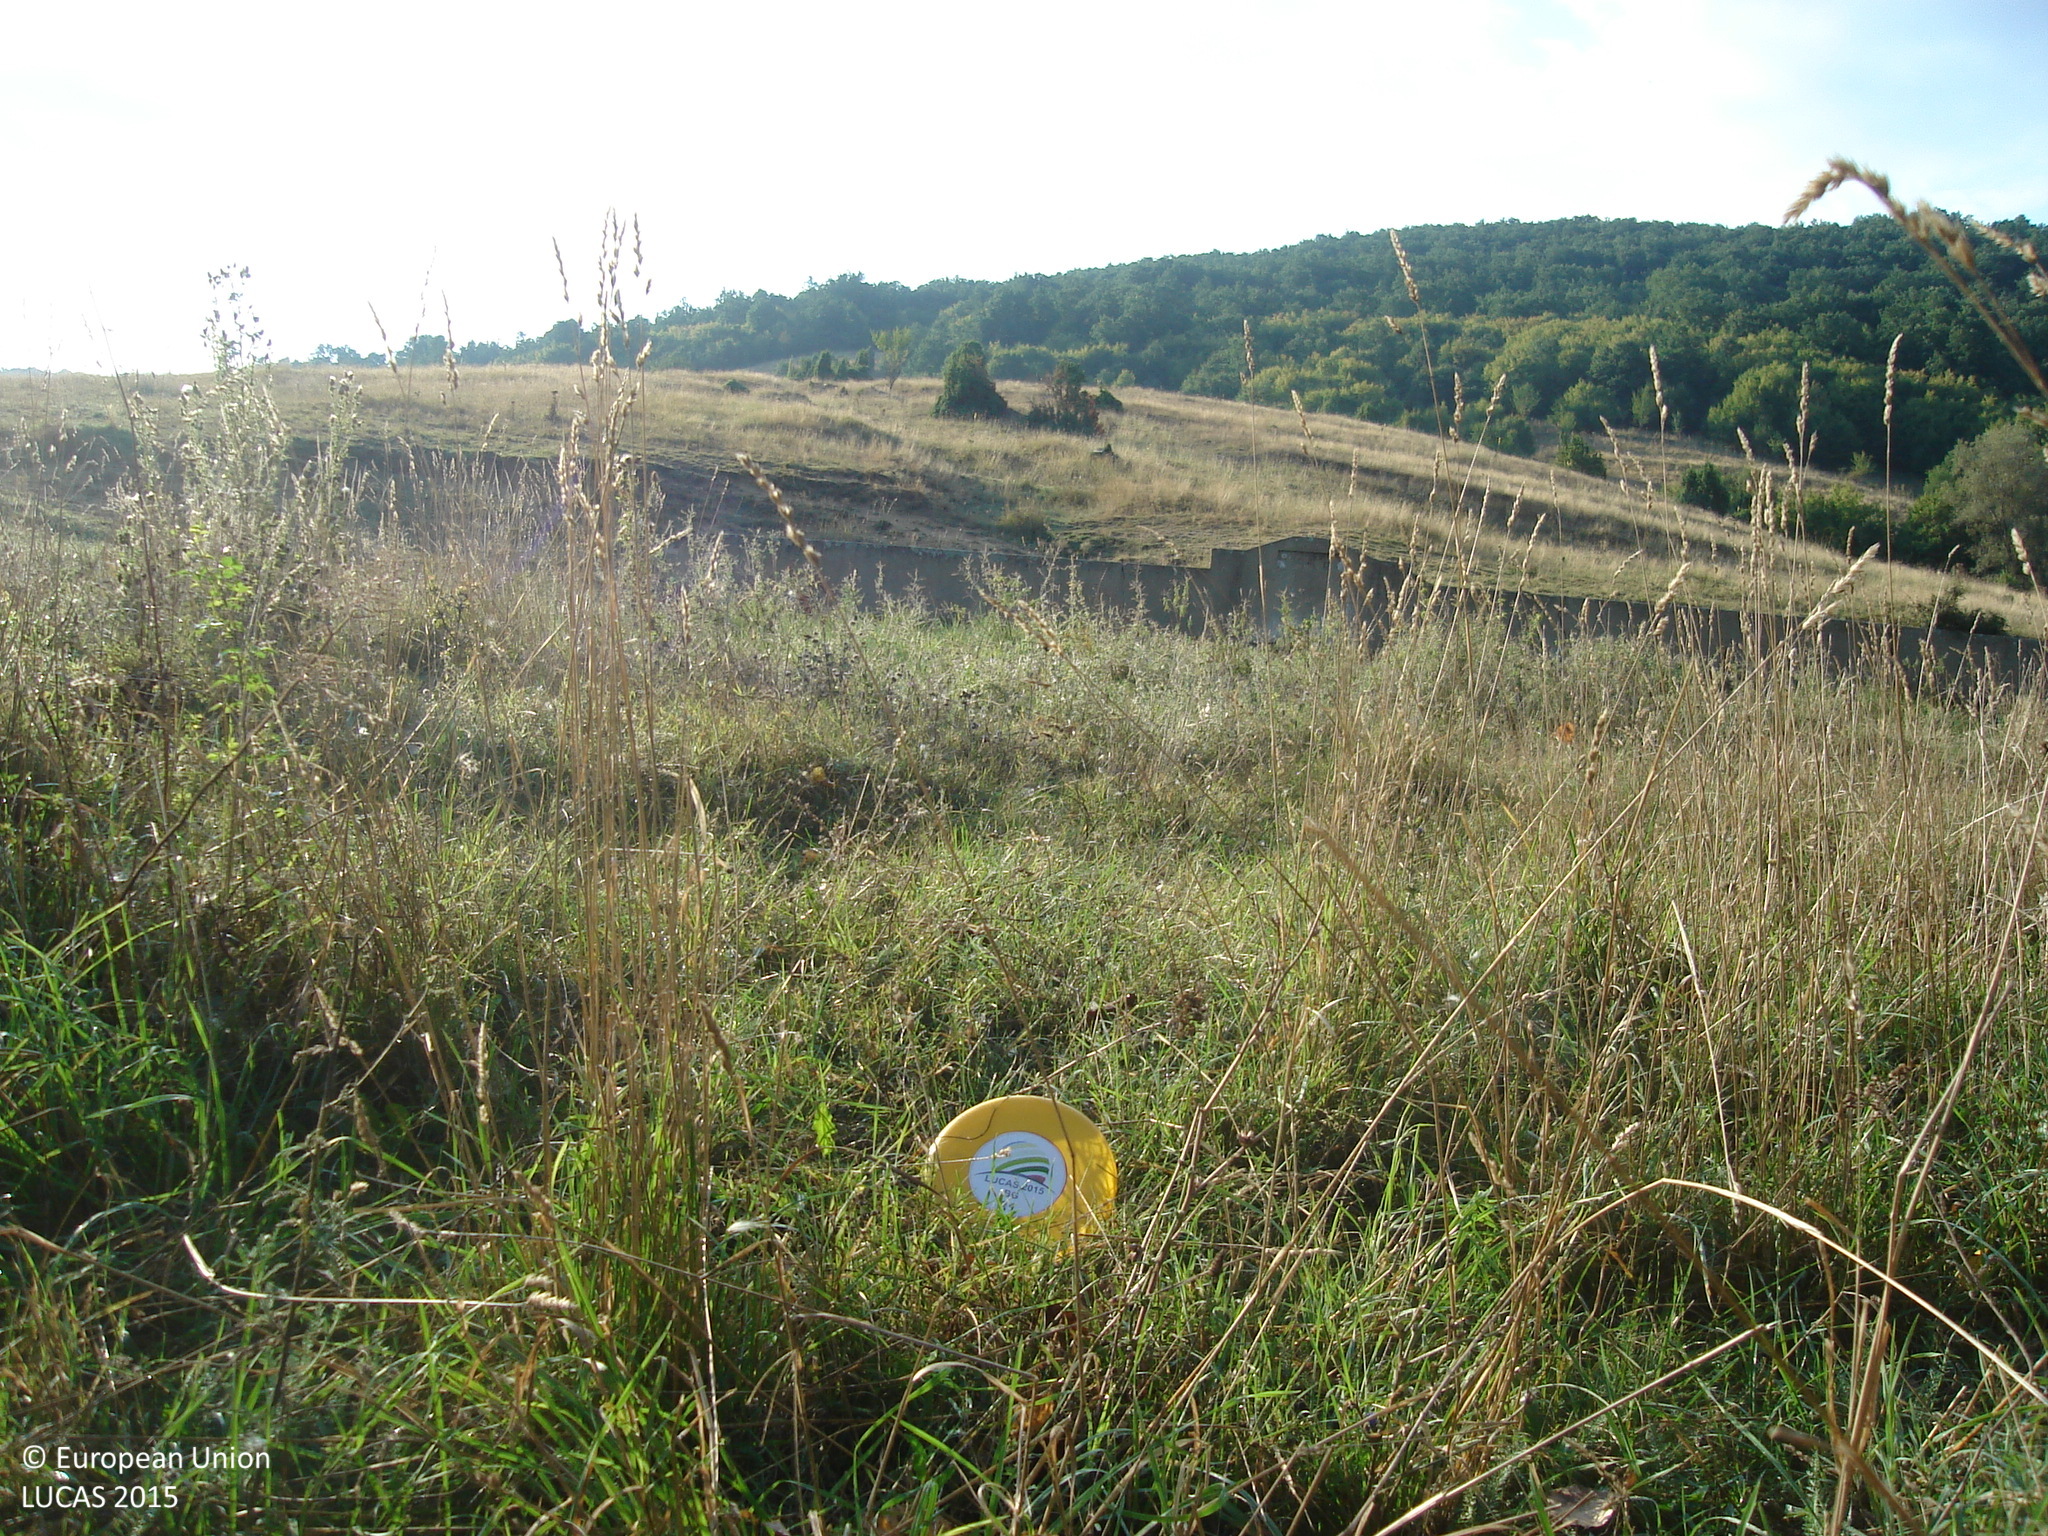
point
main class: Grassland
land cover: Grassland without tree/shrub cover
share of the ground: > 75 %
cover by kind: herbaceous plants 95 %, shrubs 5 %
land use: Agriculture (excluding fallow land and kitchen gardens)
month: September
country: BG
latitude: 42.6448
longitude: 24.0095
